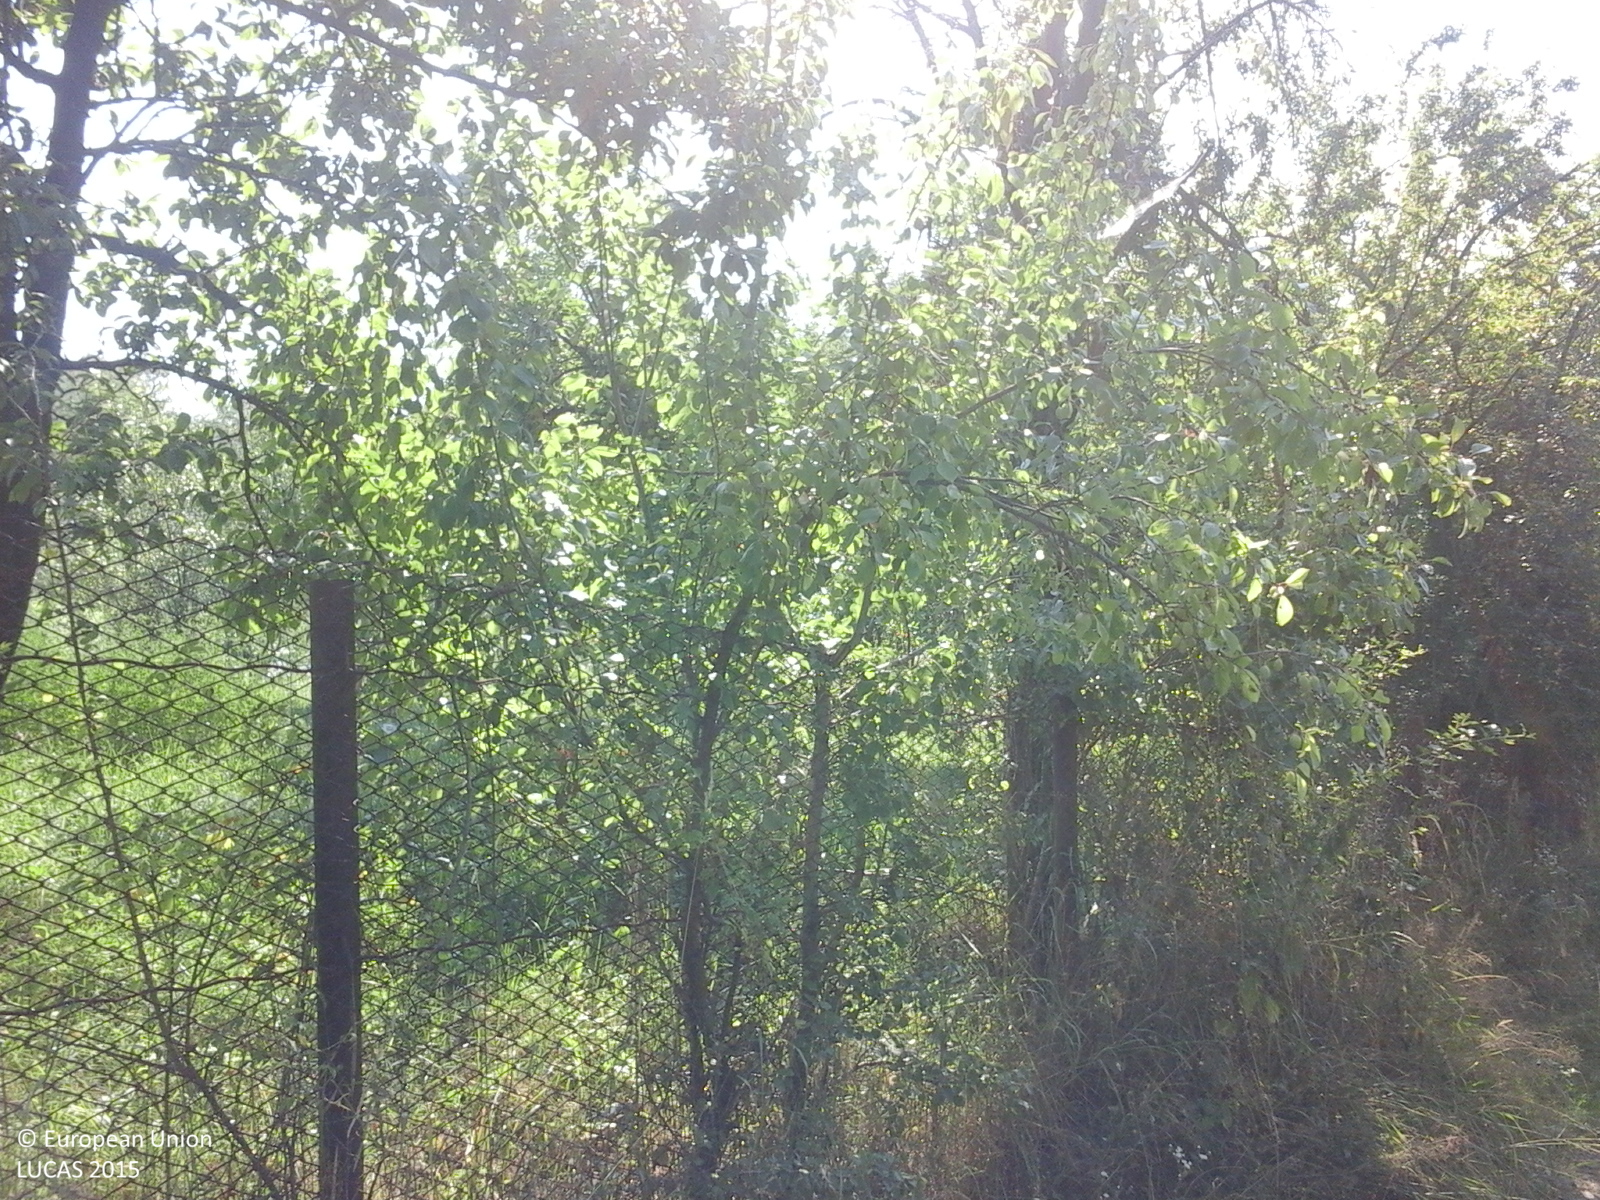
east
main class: Cropland
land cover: Lucerne
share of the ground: > 75 %
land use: Agriculture (excluding fallow land and kitchen gardens)
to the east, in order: Lucerne; Grassland without tree/shrub cover; Lines of trees; Fences; Tracks; Spontaneously vegetated surfaces; Fences; Lines of trees; Grassland without tree/shrub cover; Maize; Lines of trees; Grassland without tree/shrub cover; Abandoned hedges; Arable land (only in case pi)
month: July
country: RO
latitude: 45.0056
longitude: 24.6560
